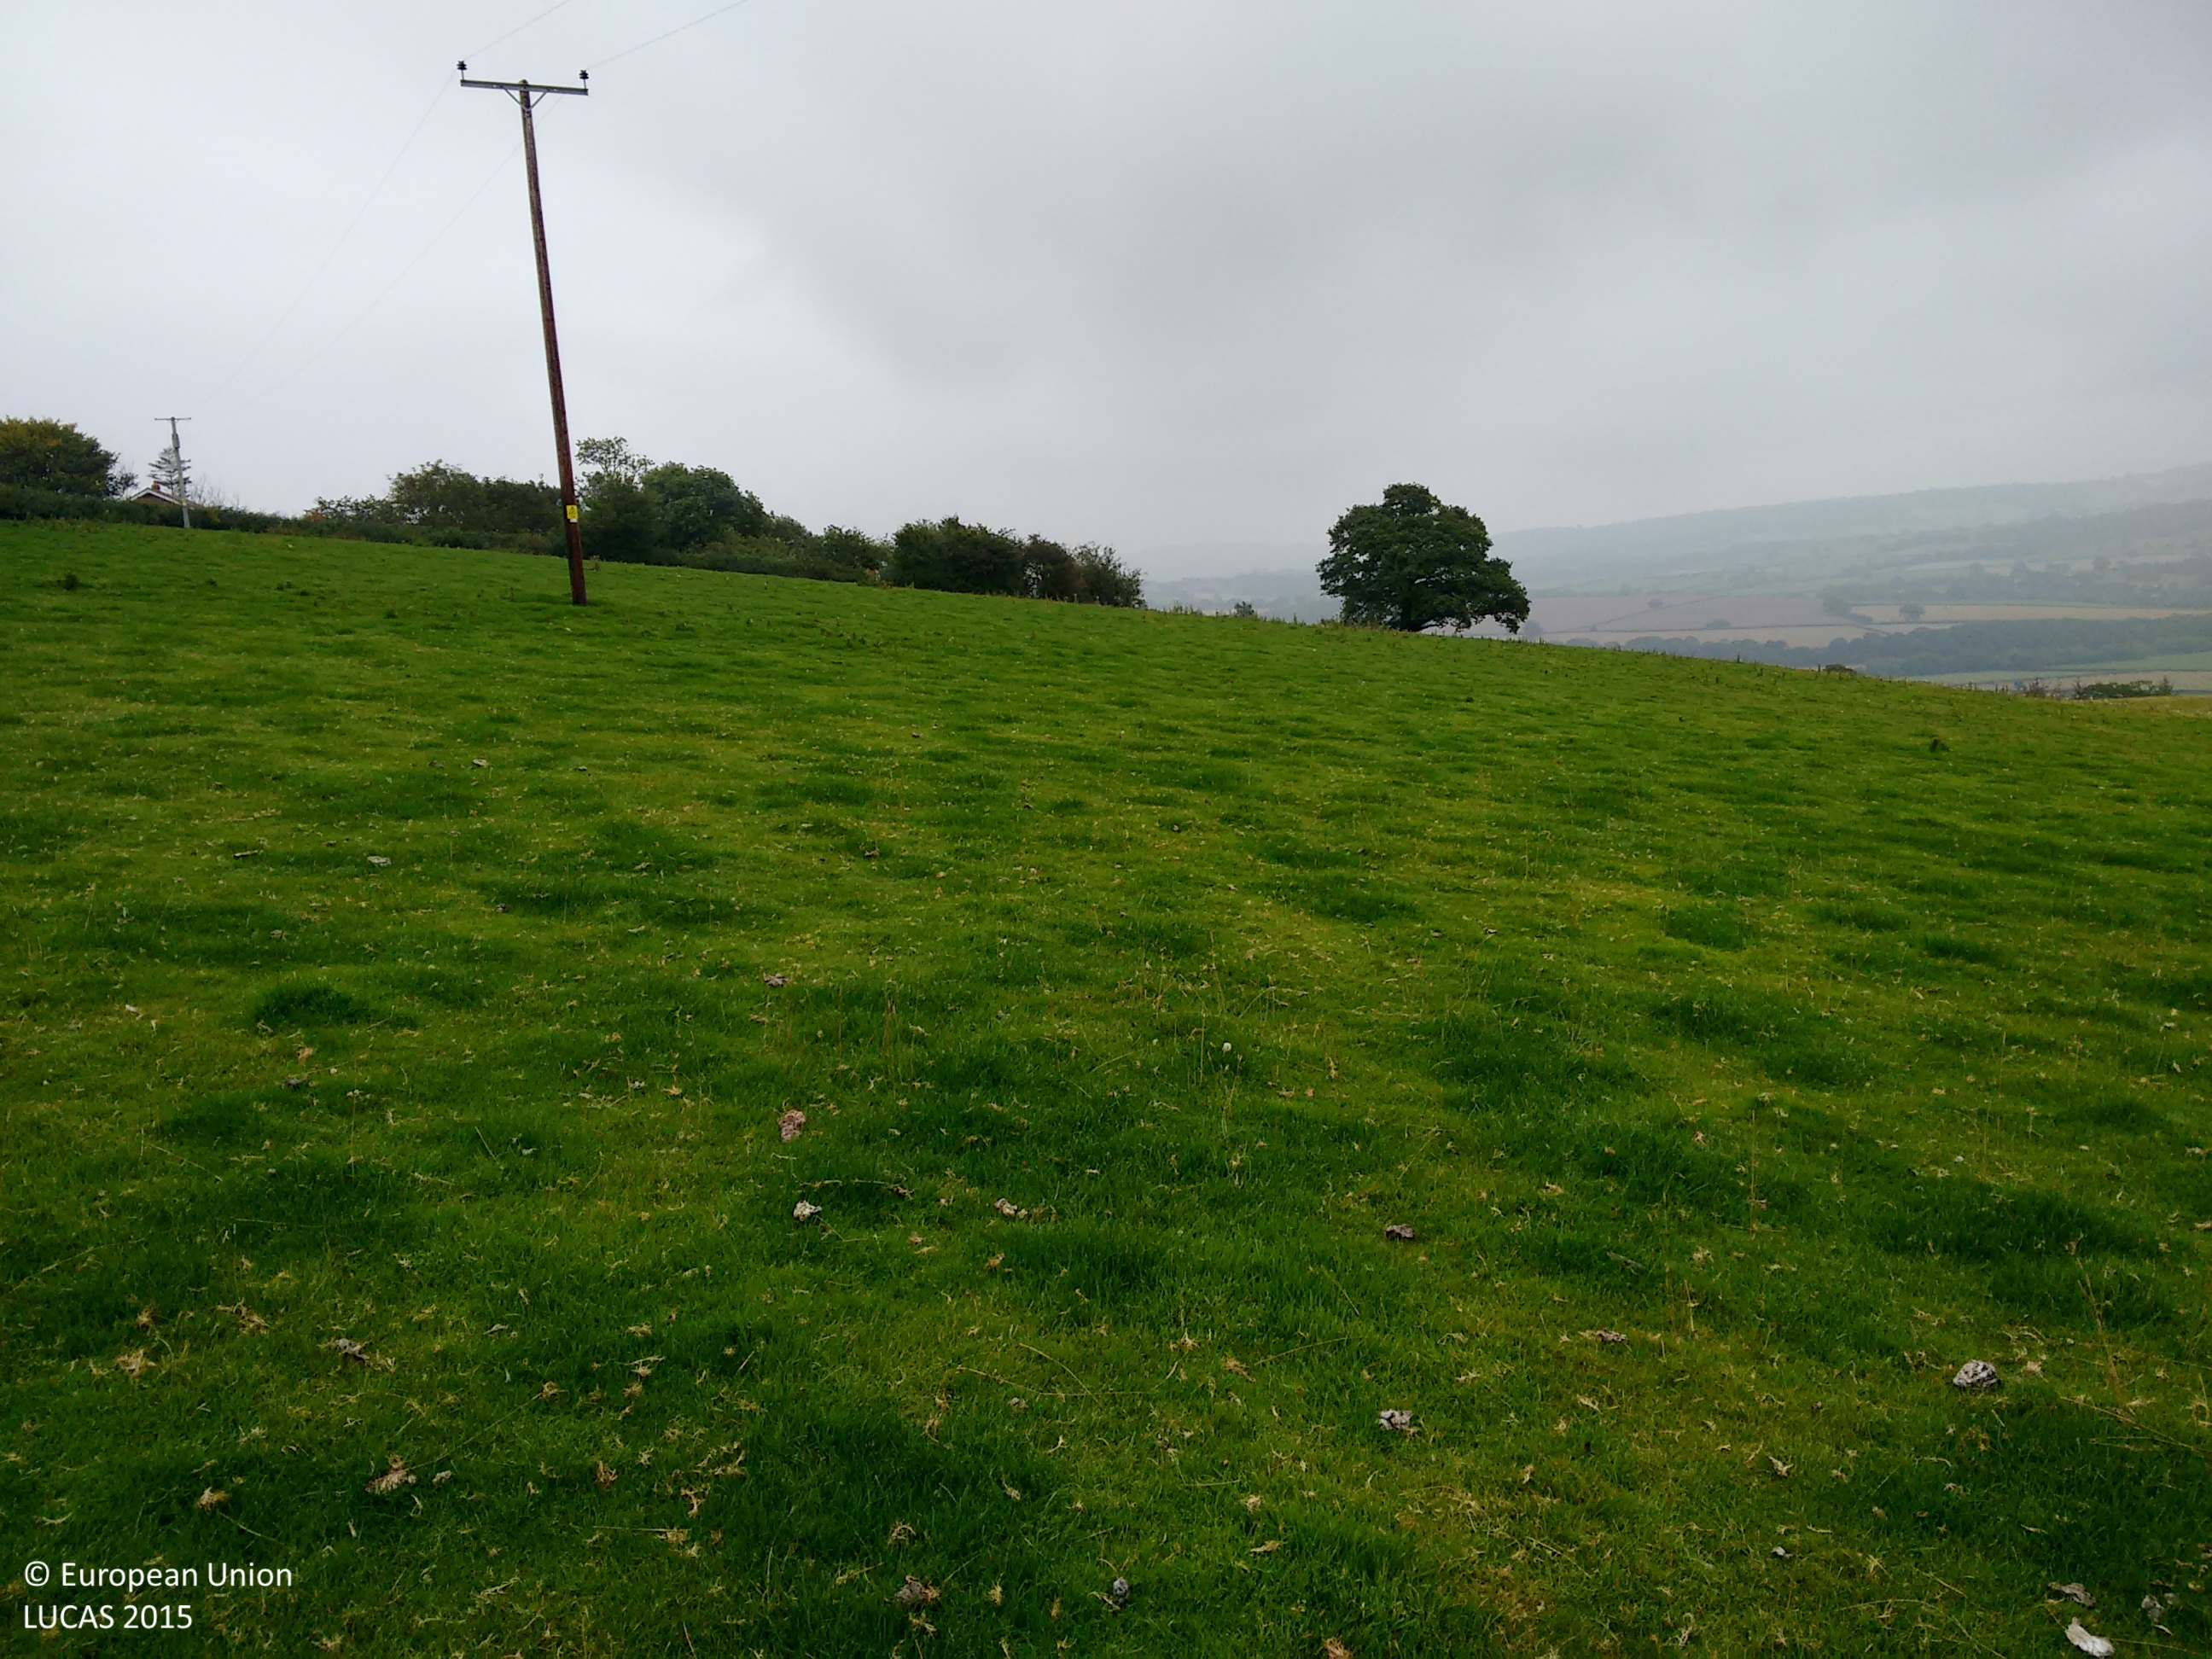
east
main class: Grassland
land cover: Grassland without tree/shrub cover
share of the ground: > 75 %
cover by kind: herbaceous plants 100 %
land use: Agriculture (excluding fallow land and kitchen gardens)
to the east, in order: Grassland without tree/shrub cover; Electric lines; Grassland without tree/shrub cover; Fences; Grassland without tree/shrub cover; Fences; Lines of trees; Ditches and canals; Grassland without tree/shrub cover
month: September
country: GB
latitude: 52.0983
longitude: -3.1428
